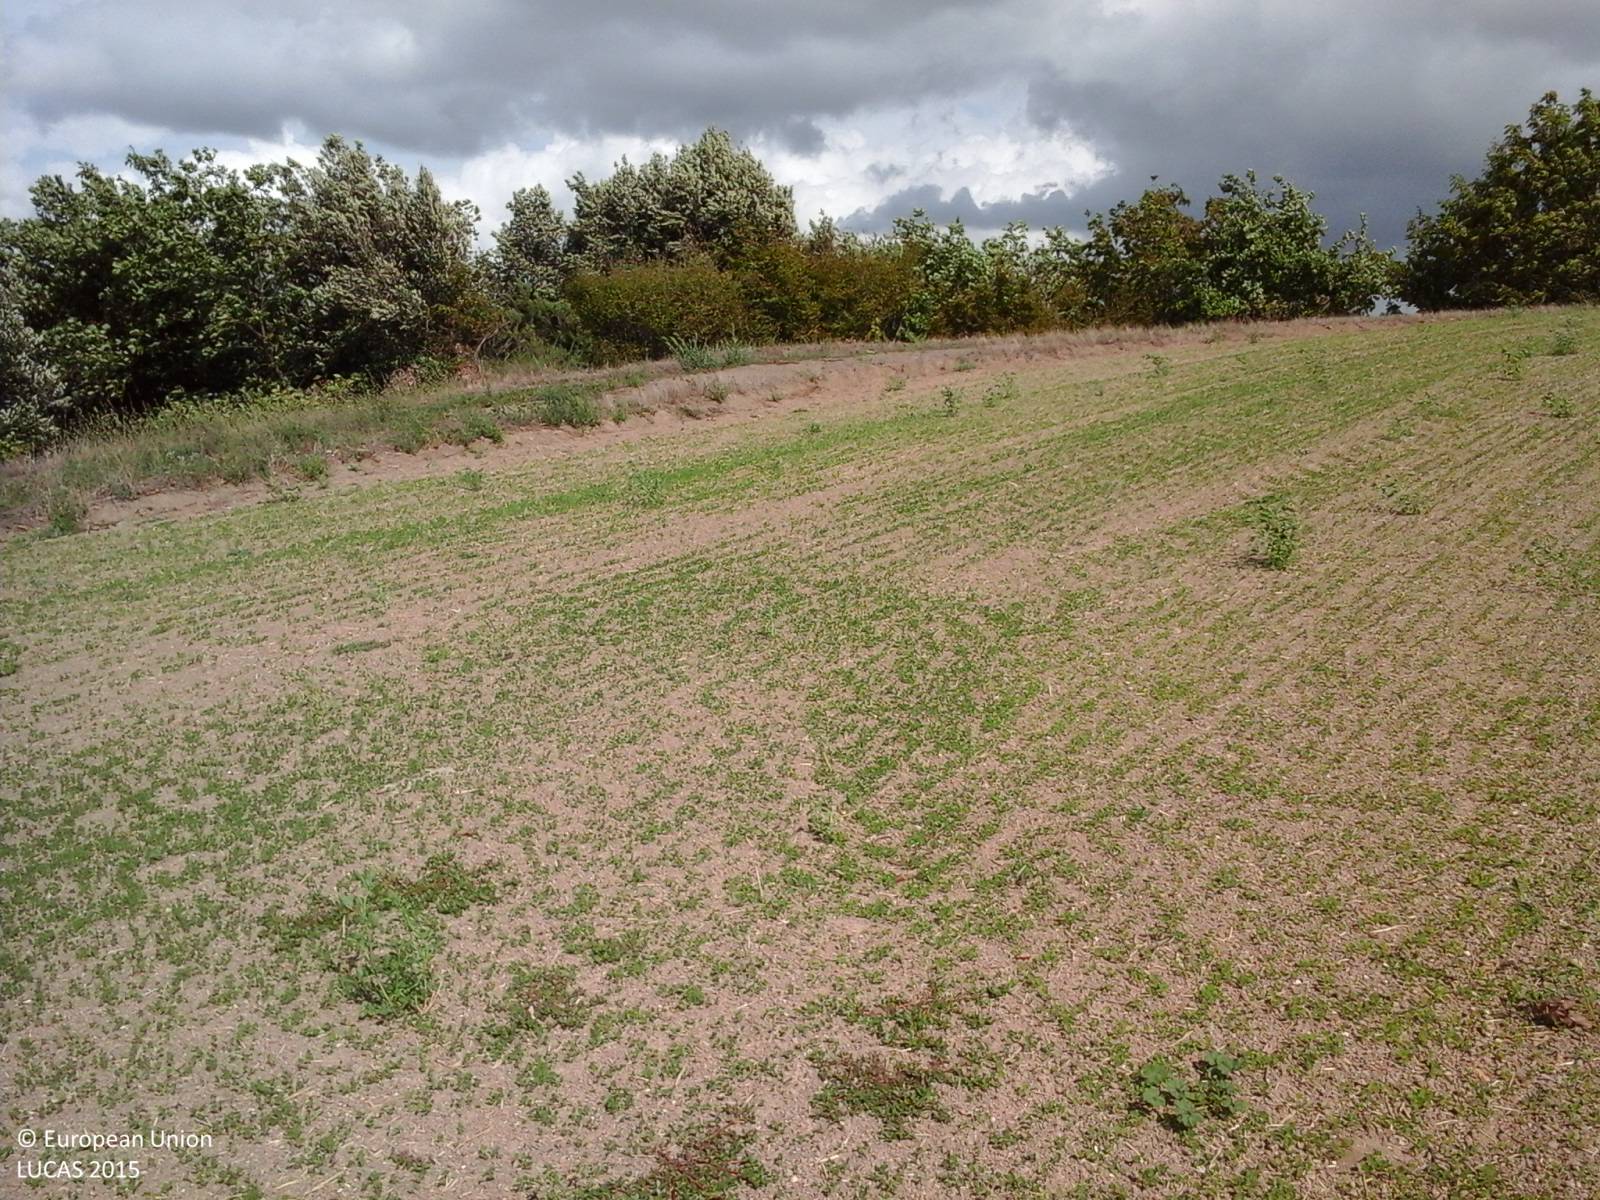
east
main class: Cropland
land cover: Clovers
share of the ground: < 10 %
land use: Agriculture (excluding fallow land and kitchen gardens)
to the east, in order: Clovers; Broadleaved woodland
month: September
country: IT
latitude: 42.3351
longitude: 12.4553
